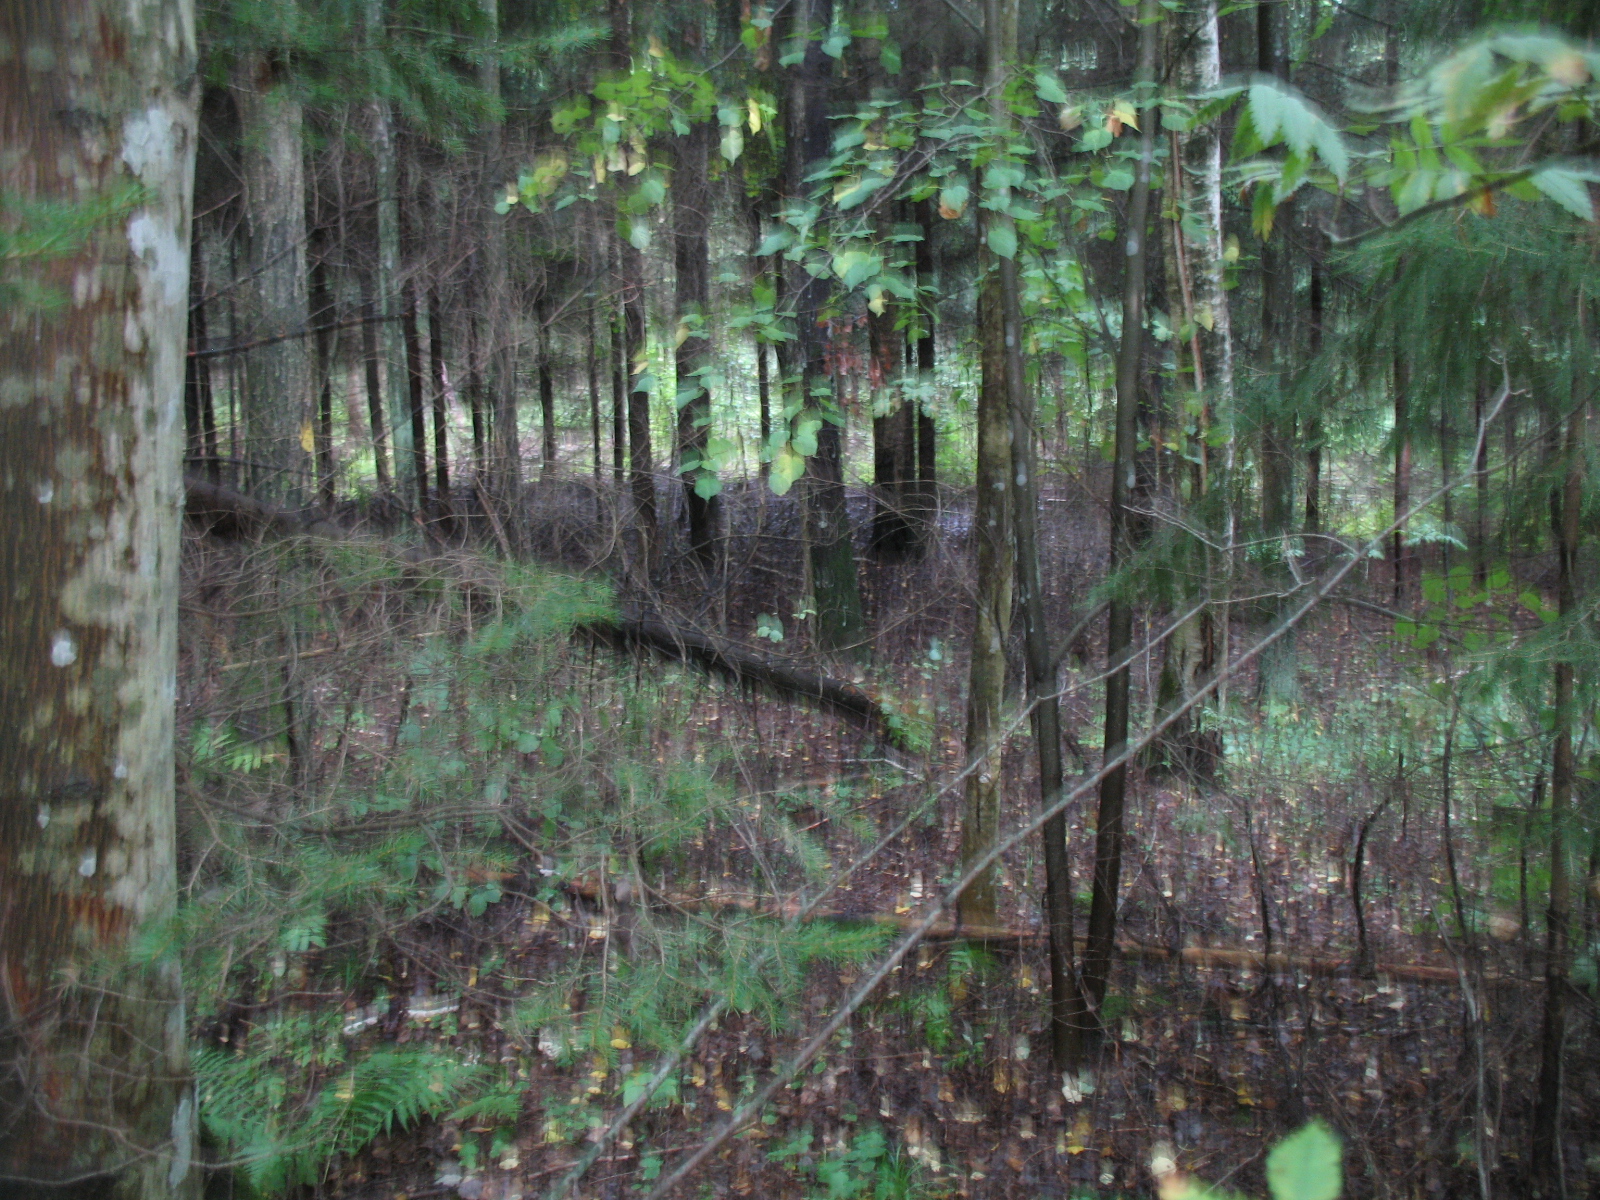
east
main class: Woodland
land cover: Spruce dominated mixed woodland
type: hemiboreal forest and nemoral coniferous forest and mixed broadleaved-coniferous forest
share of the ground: > 75 %
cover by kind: broadleaved forest trees 45 %, coniferous forest trees 40 %, herbaceous plants 10 %, unconsolidated bare surface 5 %
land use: Forestry
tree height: > 5 m
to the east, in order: Spruce dominated mixed woodland; Spruce dominated coniferous woodland
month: September
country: LV
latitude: 56.1047
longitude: 25.9056
